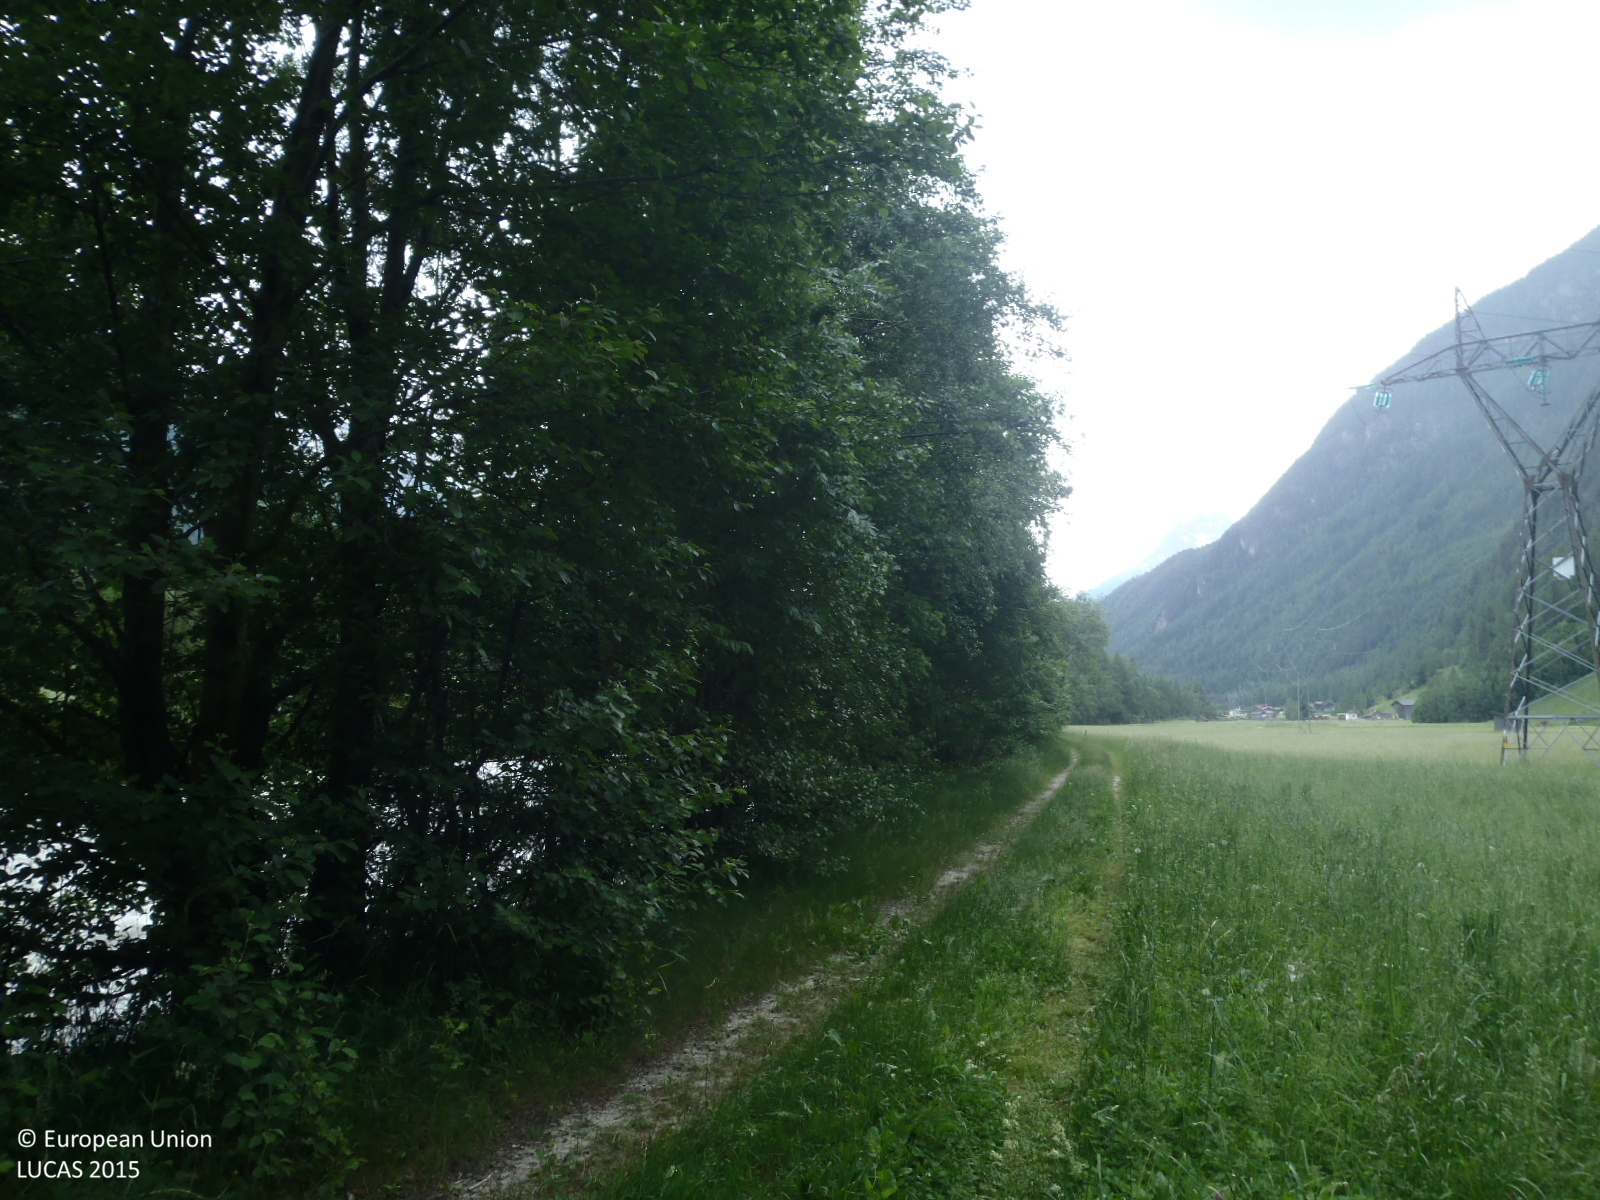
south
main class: Grassland
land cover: Grassland without tree/shrub cover
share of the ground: > 75 %
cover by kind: herbaceous plants 100 %
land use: Agriculture (excluding fallow land and kitchen gardens)
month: June
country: AT
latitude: 47.1578
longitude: 10.9092
